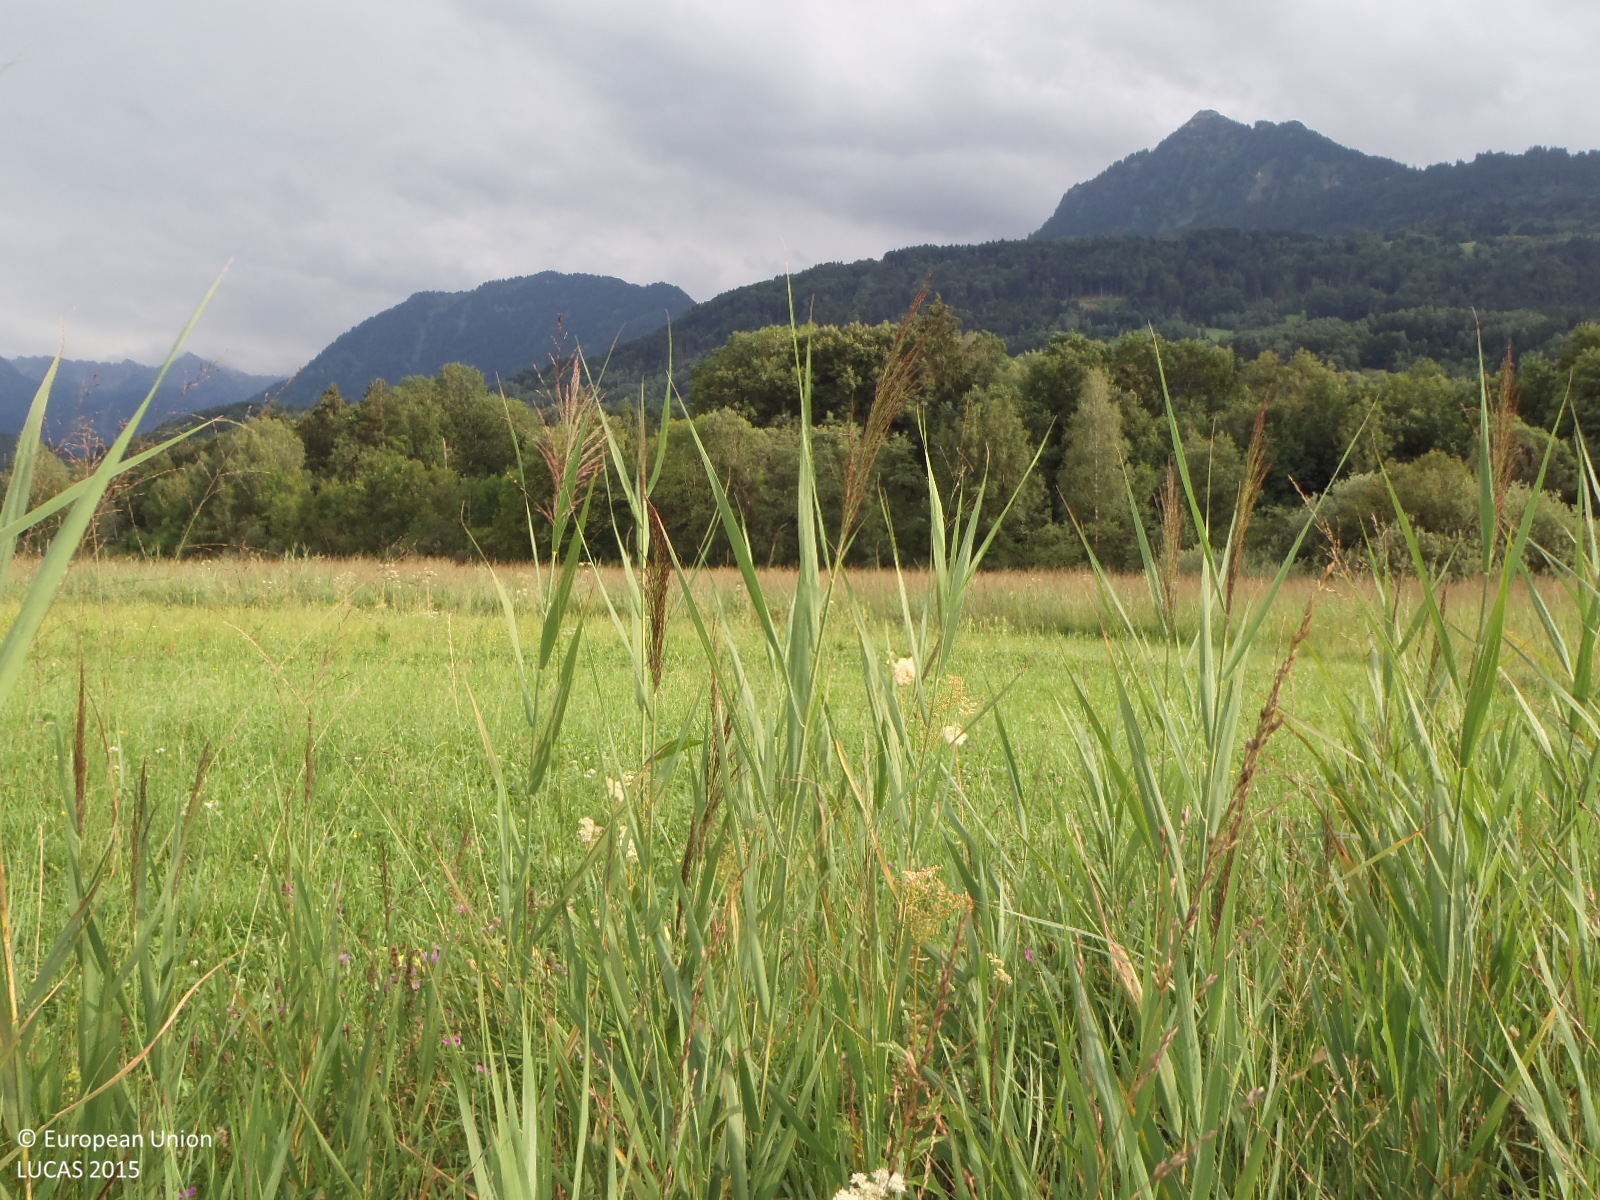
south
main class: Grassland
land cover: Grassland without tree/shrub cover
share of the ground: > 75 %
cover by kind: herbaceous plants 100 %
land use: Agriculture (excluding fallow land and kitchen gardens)
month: July
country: AT
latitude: 47.2150
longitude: 9.6438
